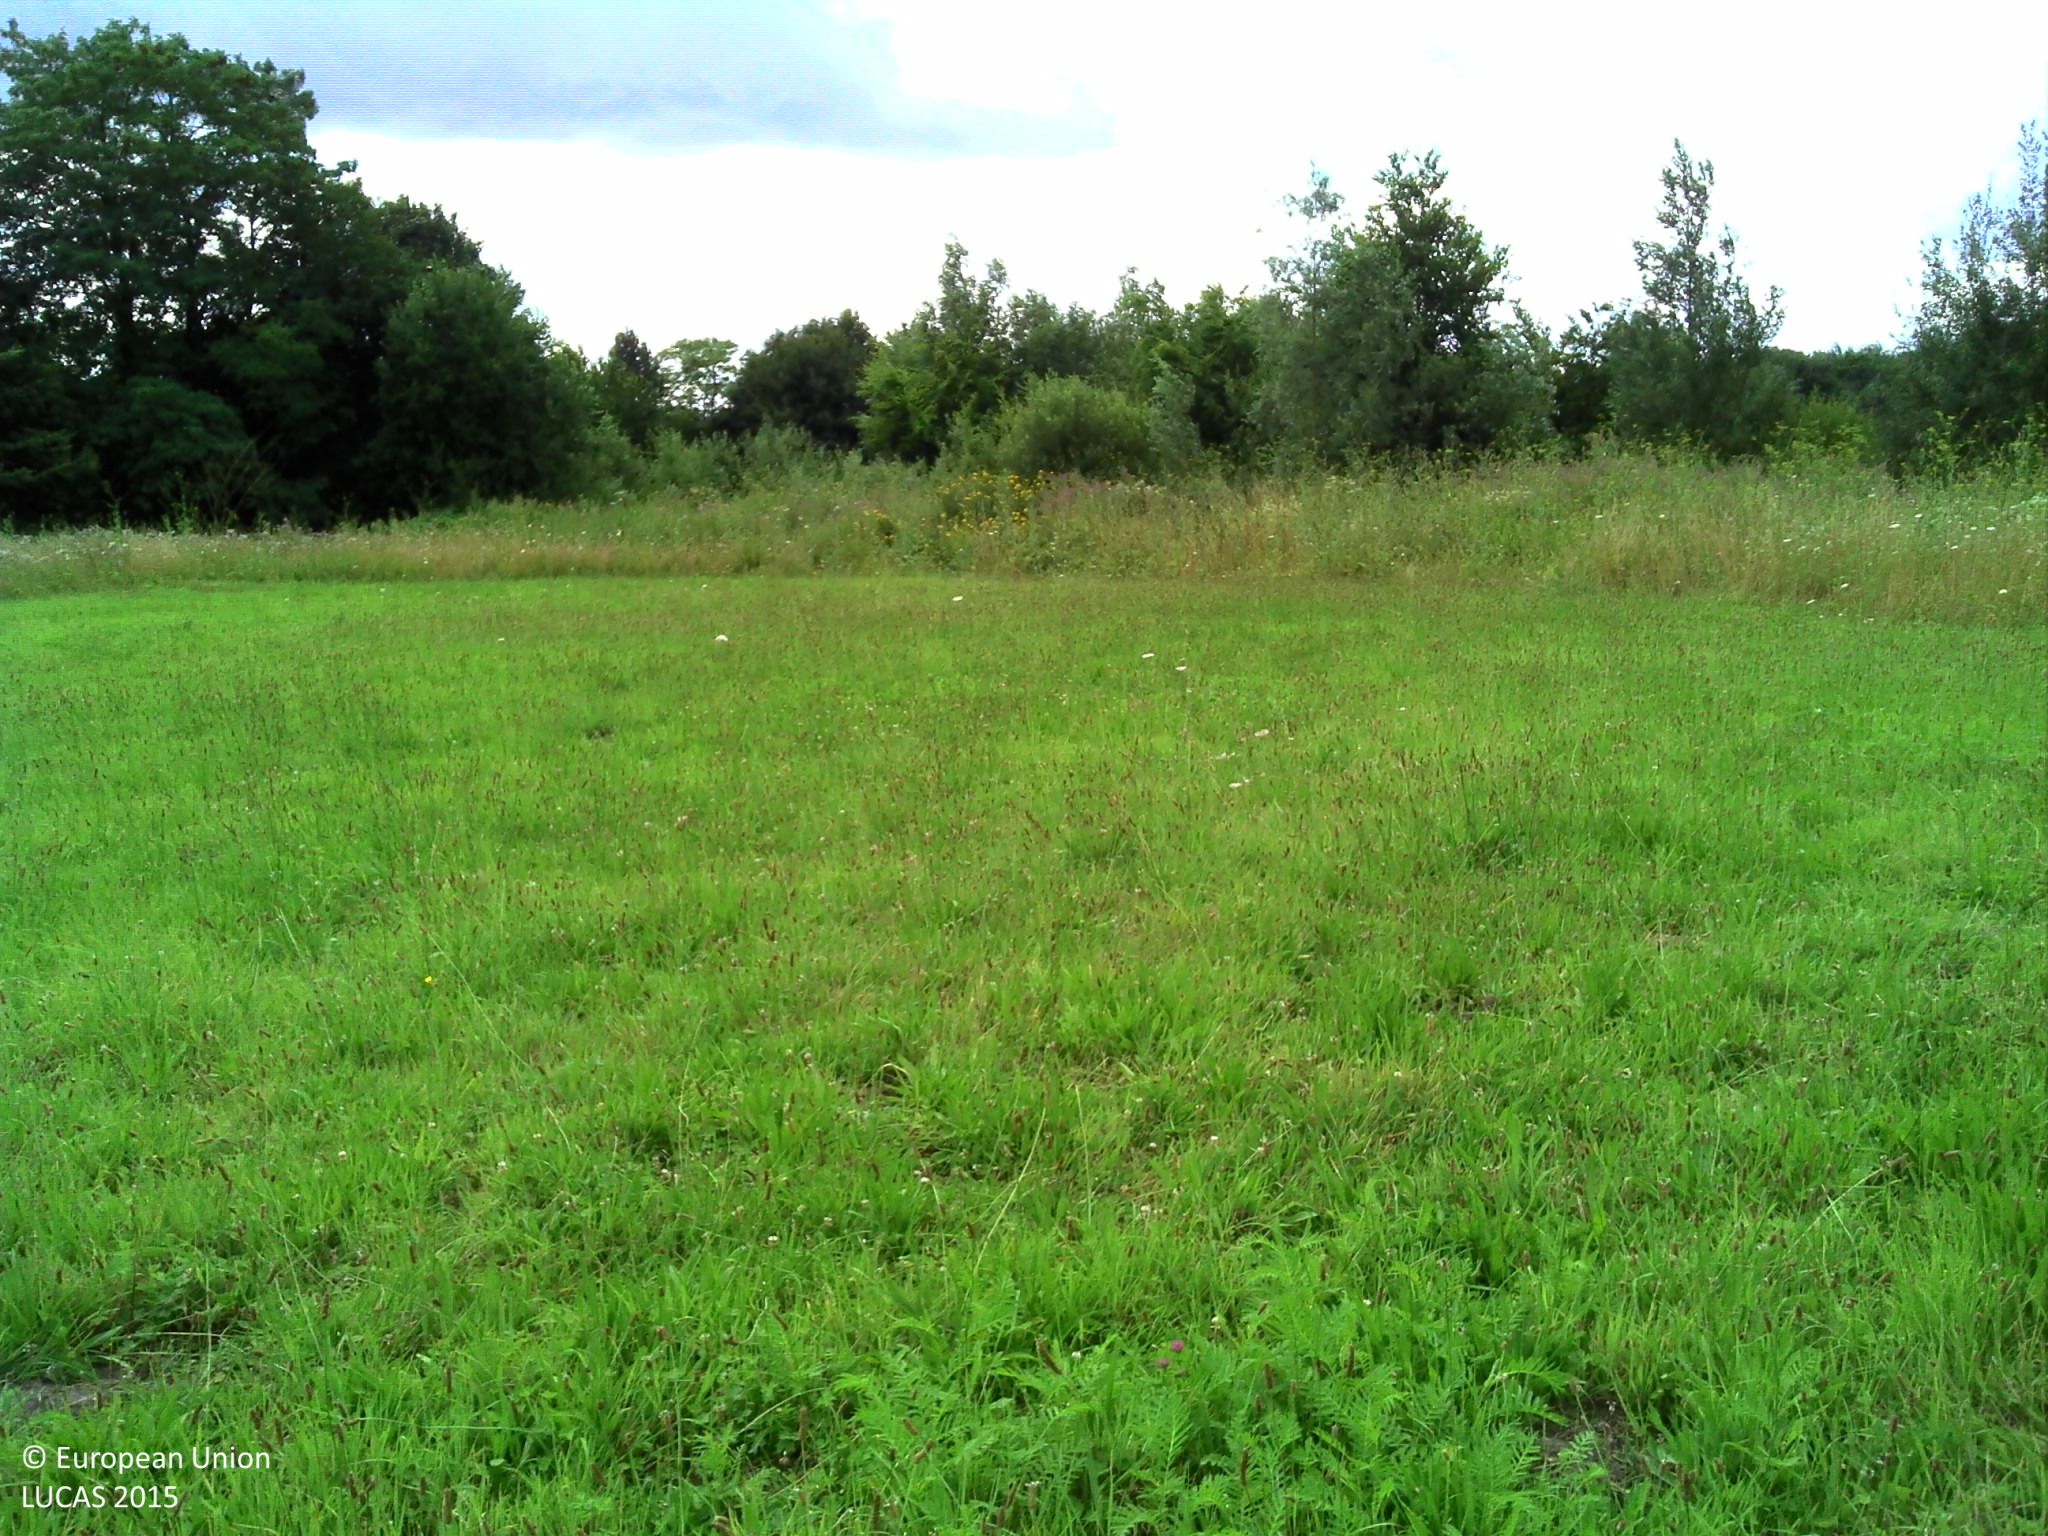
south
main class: Grassland
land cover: Grassland without tree/shrub cover
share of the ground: > 75 %
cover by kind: herbaceous plants 100 %
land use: Agriculture (excluding fallow land and kitchen gardens)
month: July
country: FR
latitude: 50.4740
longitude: 3.6097
